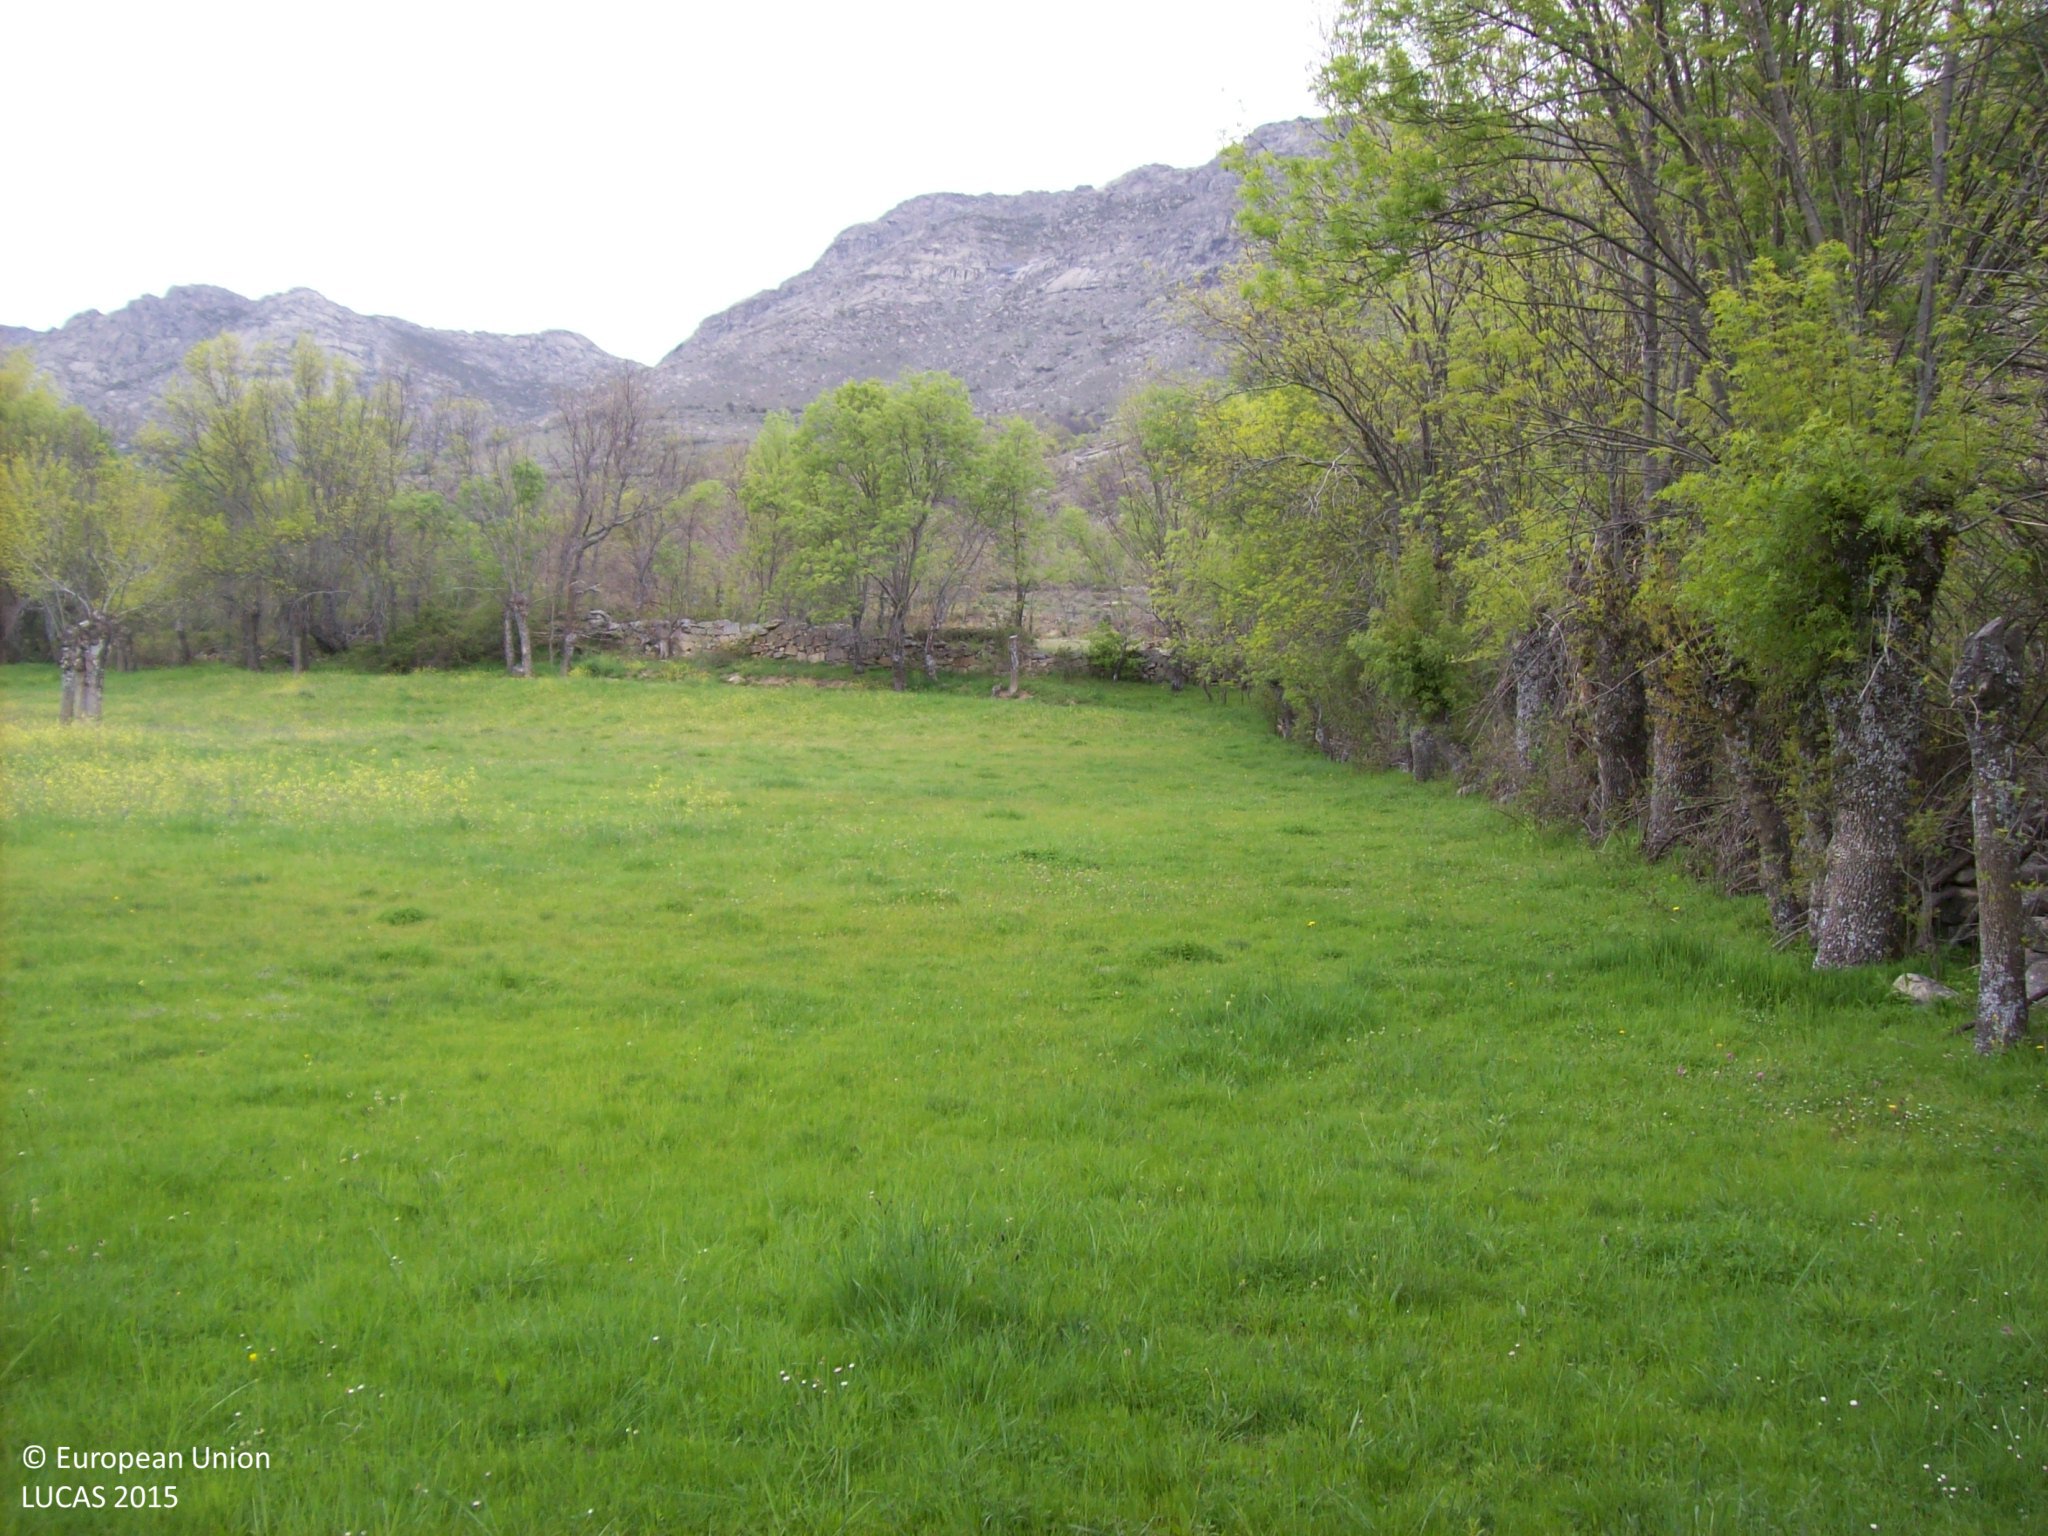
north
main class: Grassland
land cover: Grassland without tree/shrub cover
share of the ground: > 75 %
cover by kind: herbaceous plants 100 %
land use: Agriculture (excluding fallow land and kitchen gardens)
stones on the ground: < 10 %
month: April
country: ES
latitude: 40.4584
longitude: -4.8070
